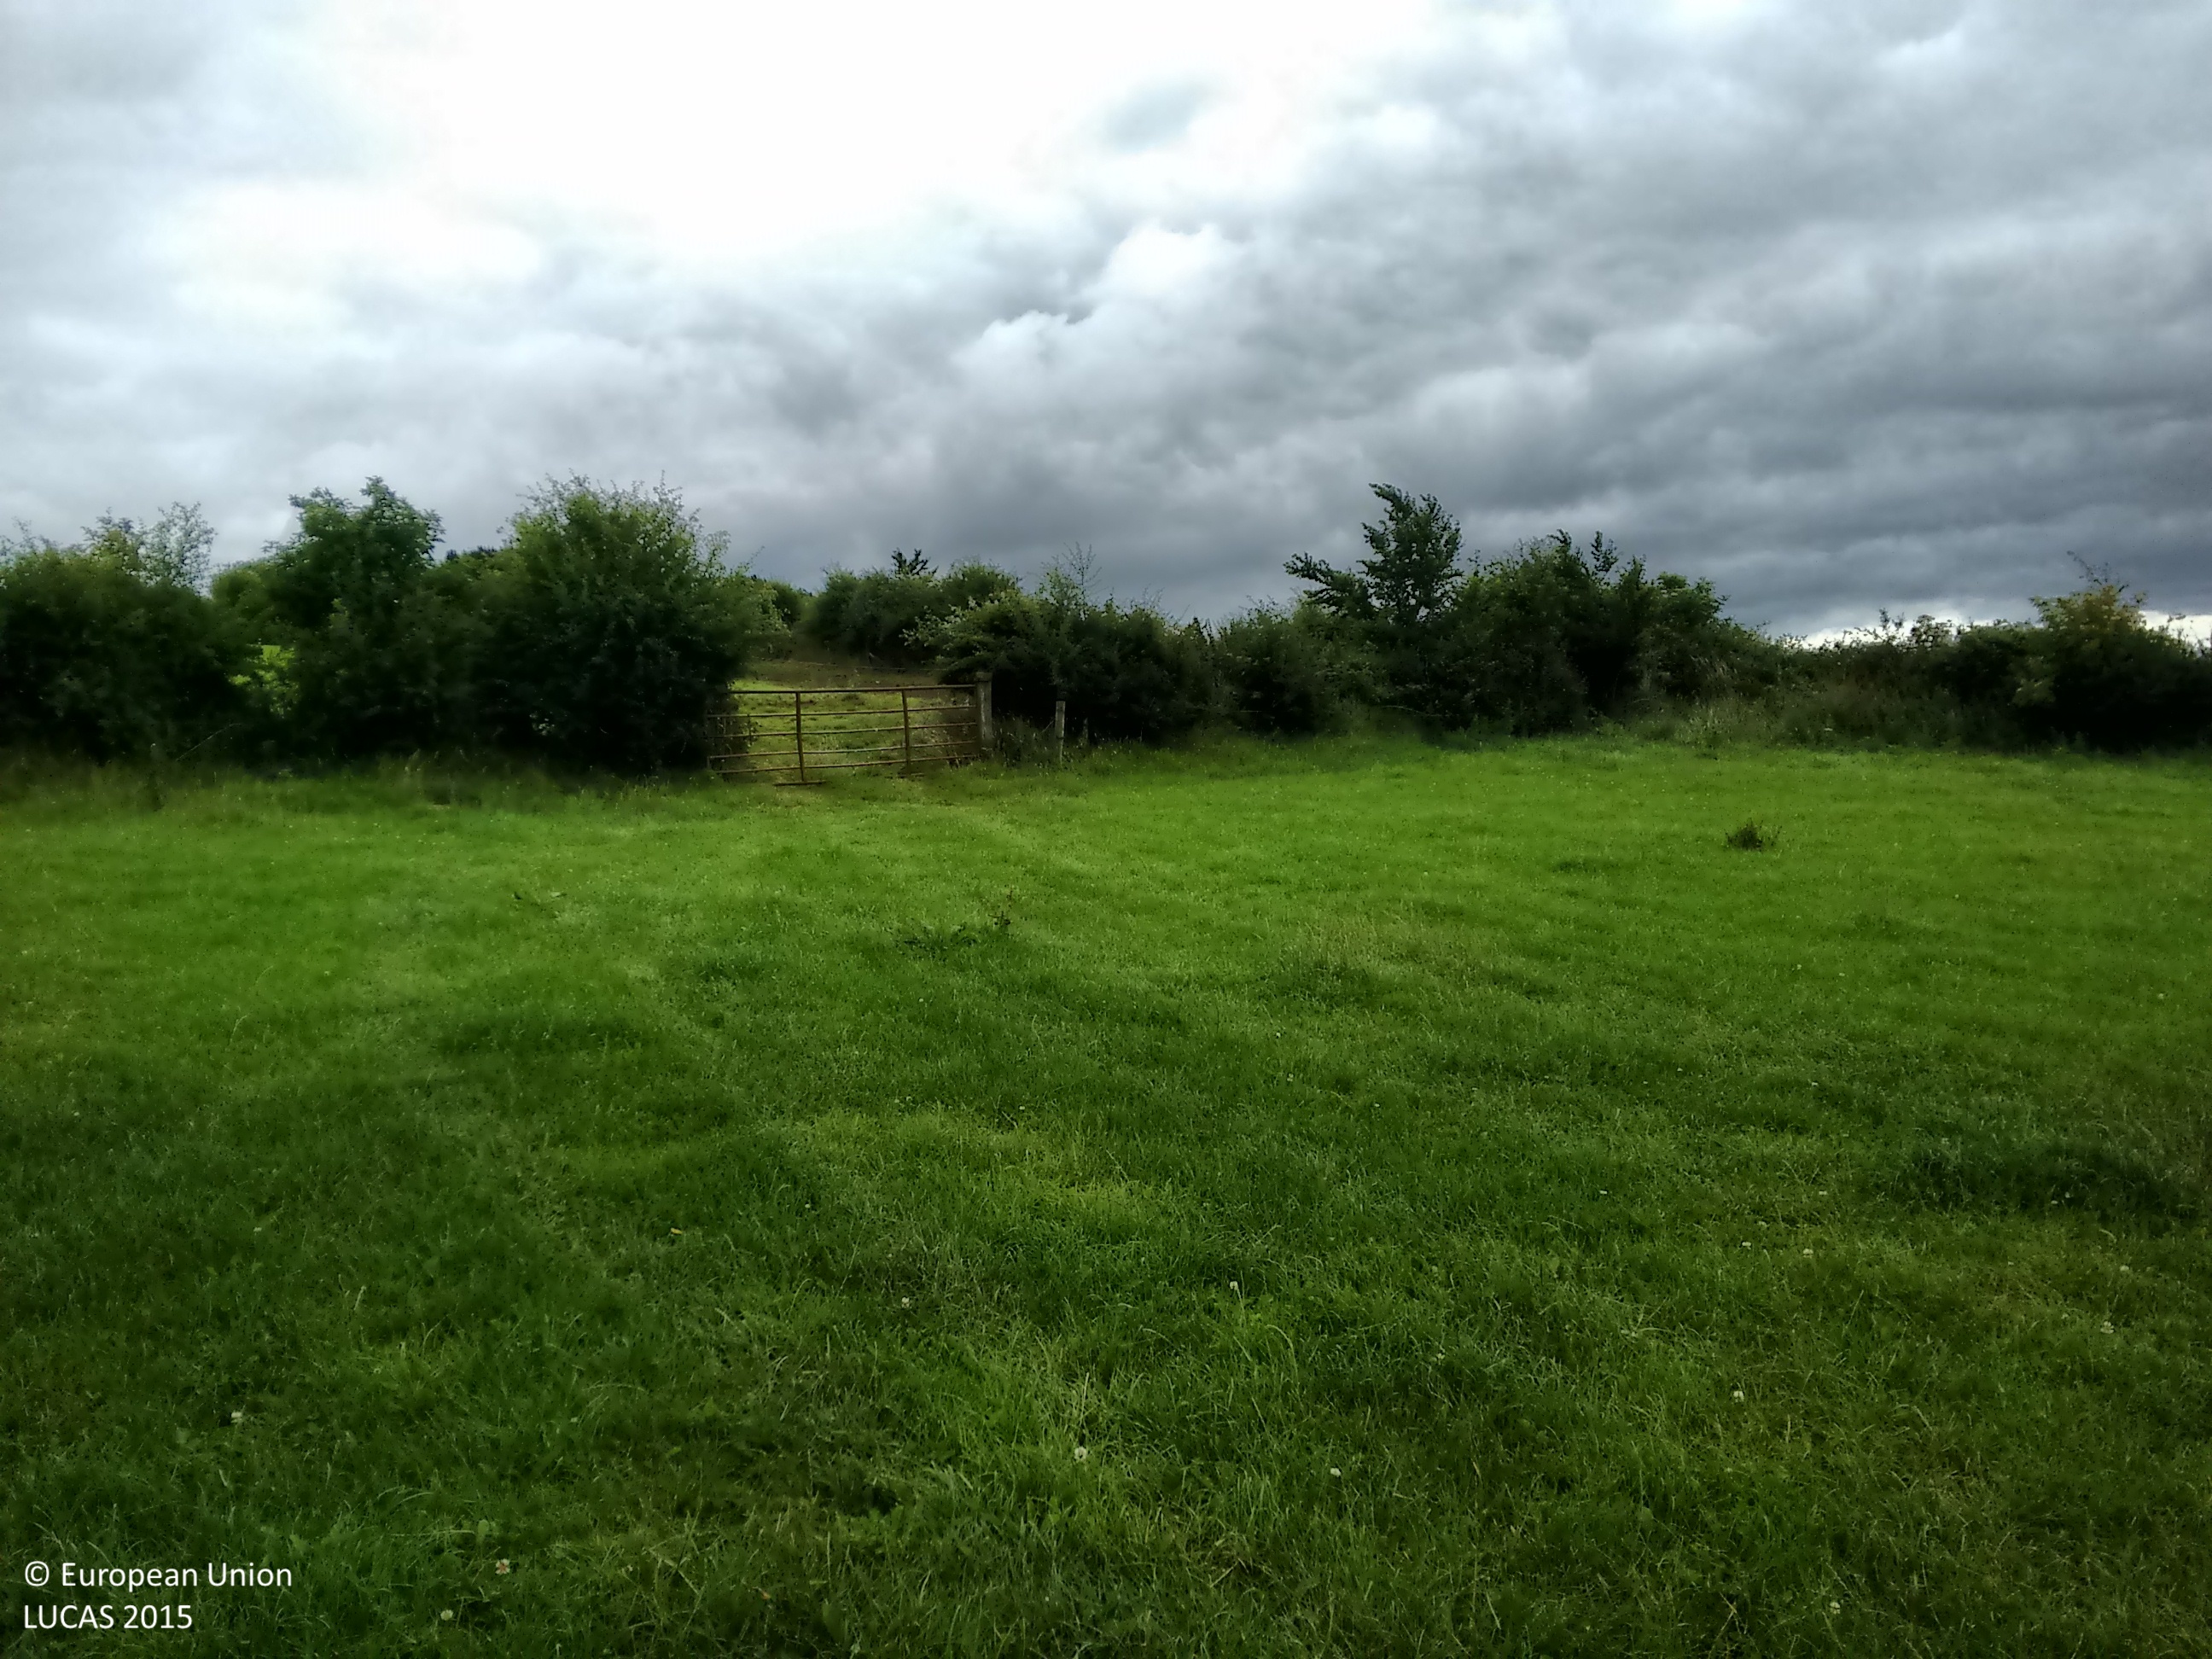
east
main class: Grassland
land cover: Grassland without tree/shrub cover
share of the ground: > 75 %
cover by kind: herbaceous plants 100 %
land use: Agriculture (excluding fallow land and kitchen gardens)
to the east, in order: Grassland without tree/shrub cover; Fences; Abandoned hedges; Fences; Tracks; Fences; Abandoned hedges; Fences; Grassland without tree/shrub cover; Fences; Abandoned hedges; Fences; Grassland without tree/shrub cover; Fences; Abandoned hedges
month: July
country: IE
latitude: 52.7512
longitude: -7.2936
